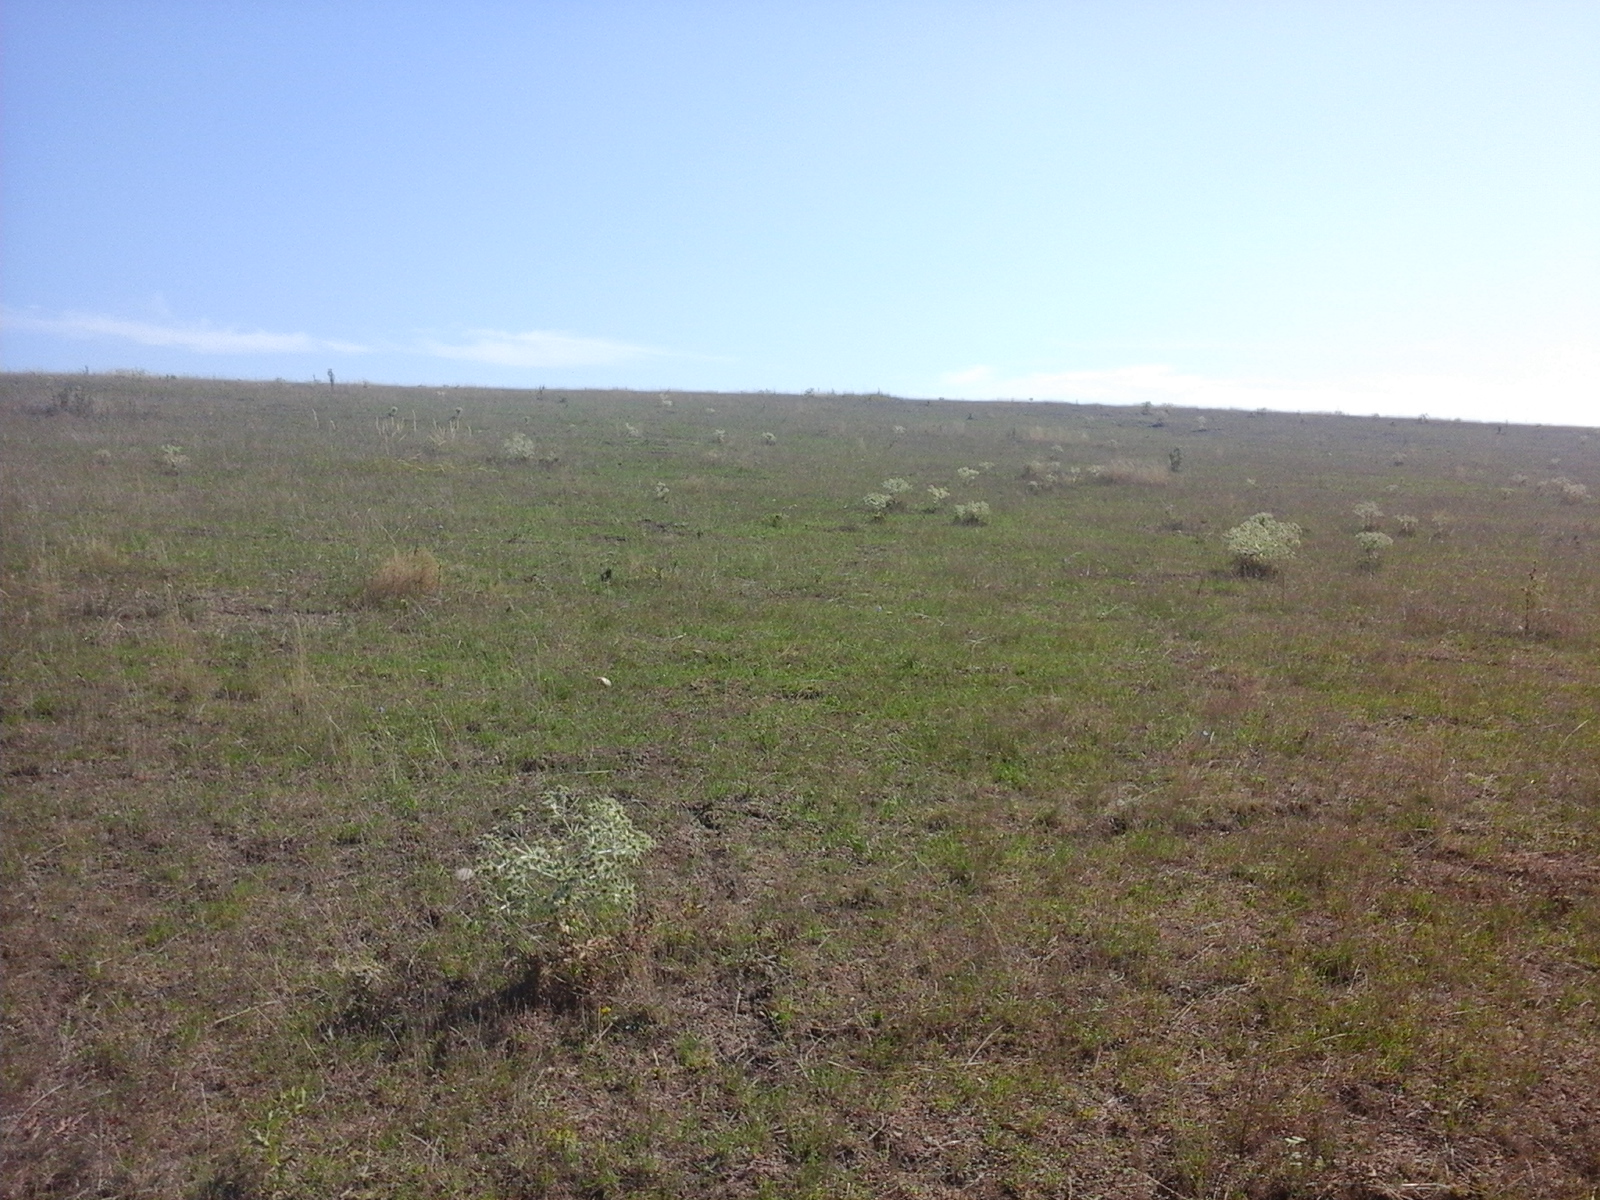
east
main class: Grassland
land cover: Grassland without tree/shrub cover
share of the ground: > 75 %
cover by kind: herbaceous plants 100 %
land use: Agriculture (excluding fallow land and kitchen gardens)
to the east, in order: Grassland without tree/shrub cover; Spontaneously vegetated surfaces
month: August
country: RO
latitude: 45.6464
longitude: 21.7509
